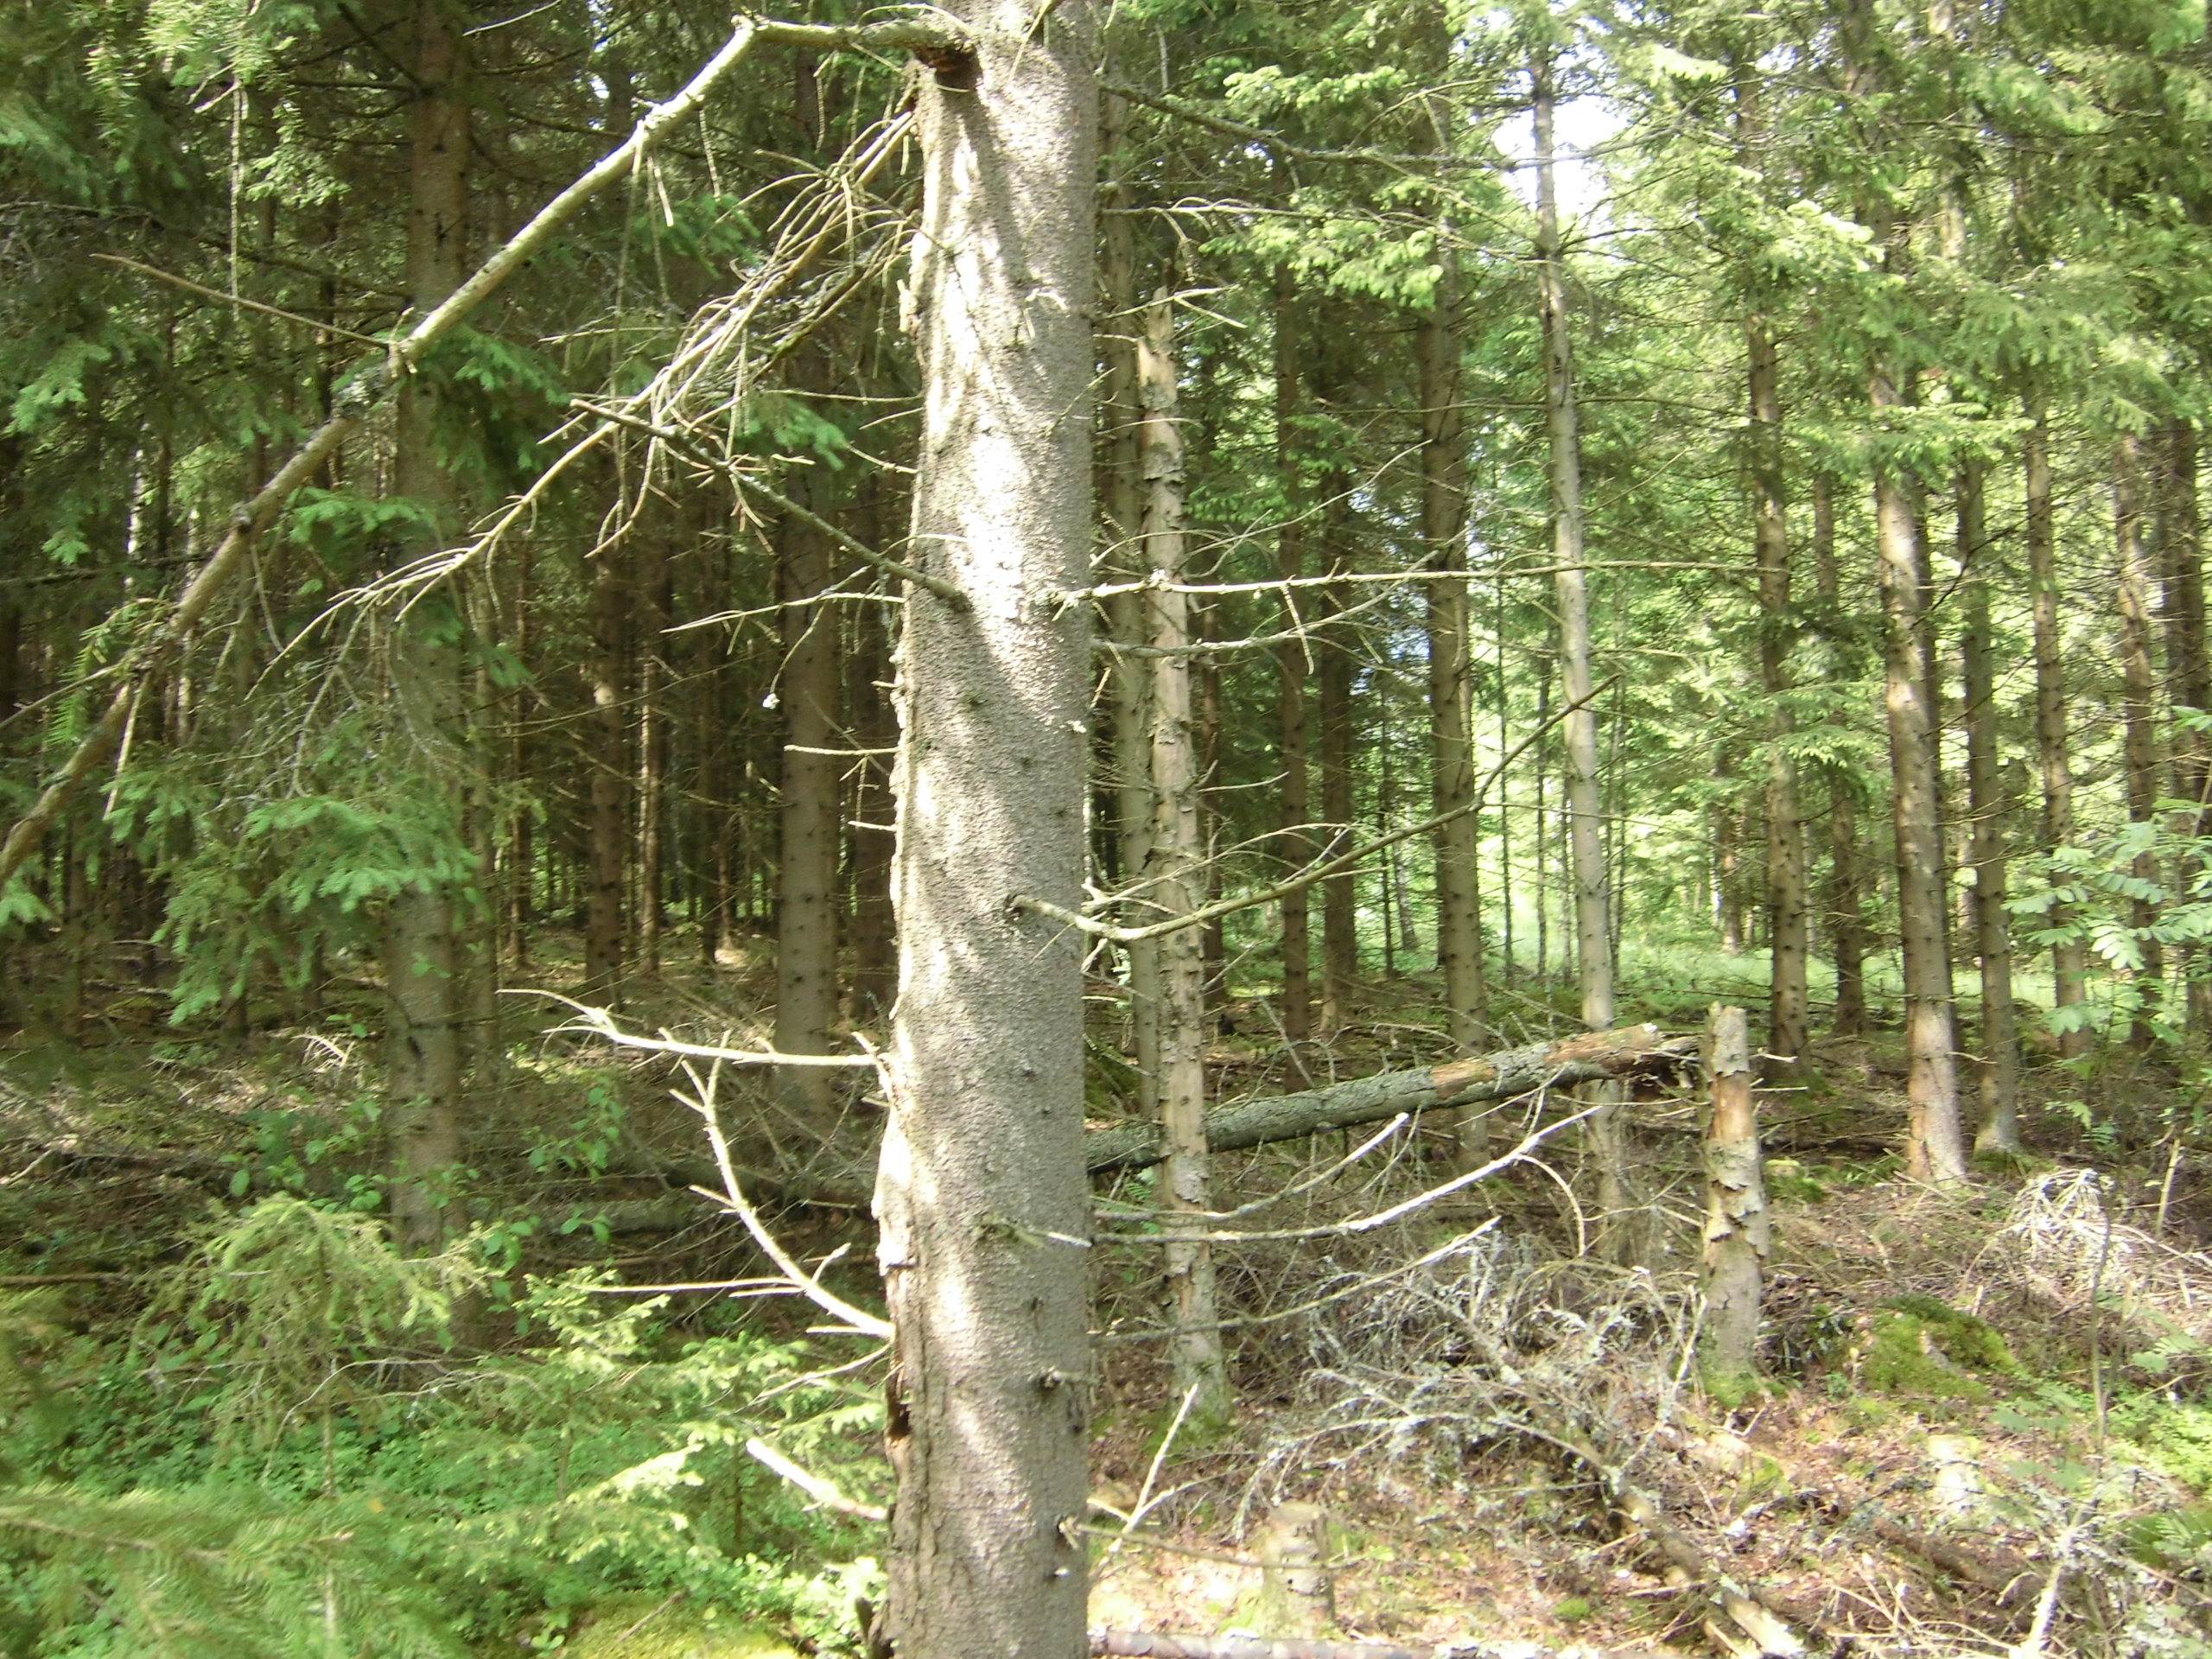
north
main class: Woodland
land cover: Spruce dominated mixed woodland
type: boreal forest
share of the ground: 50 - 75 %
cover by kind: coniferous forest trees 30 %, broadleaved forest trees 30 %, shrubs 20 %, lichens and mosses 15 %, herbaceous plants 5 %
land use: Forestry
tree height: > 5 m
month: June
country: SE
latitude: 57.0577
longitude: 14.6628
